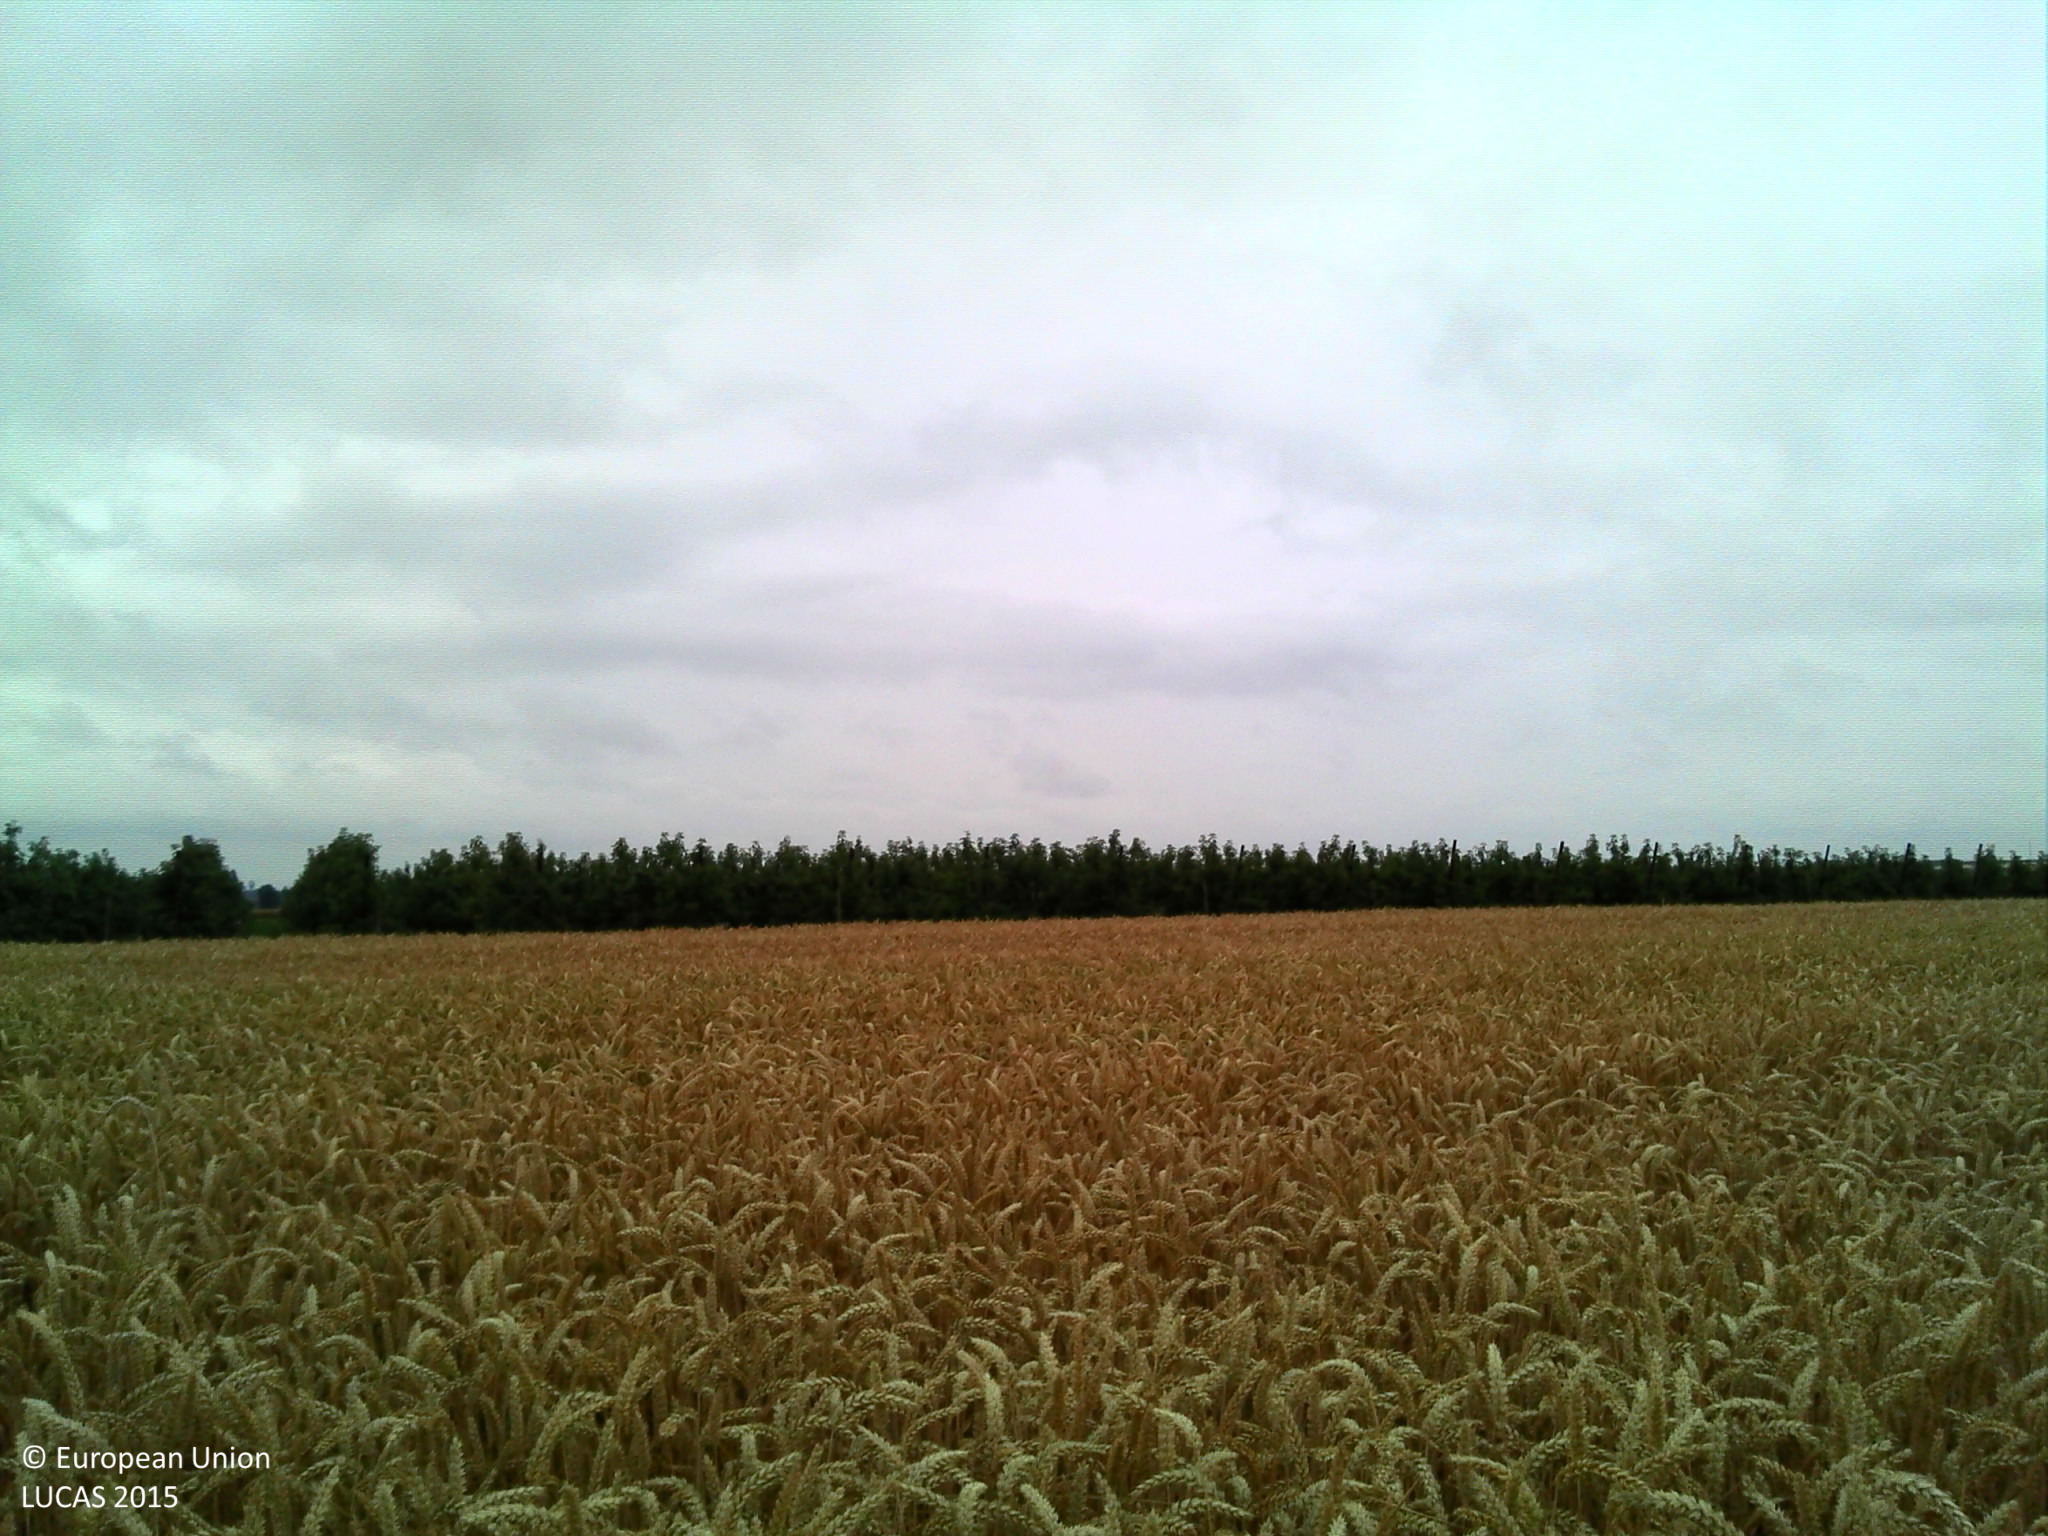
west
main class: Cropland
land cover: Common wheat
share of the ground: > 75 %
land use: Agriculture (excluding fallow land and kitchen gardens)
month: July
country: BE
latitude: 50.7817
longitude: 5.1042
